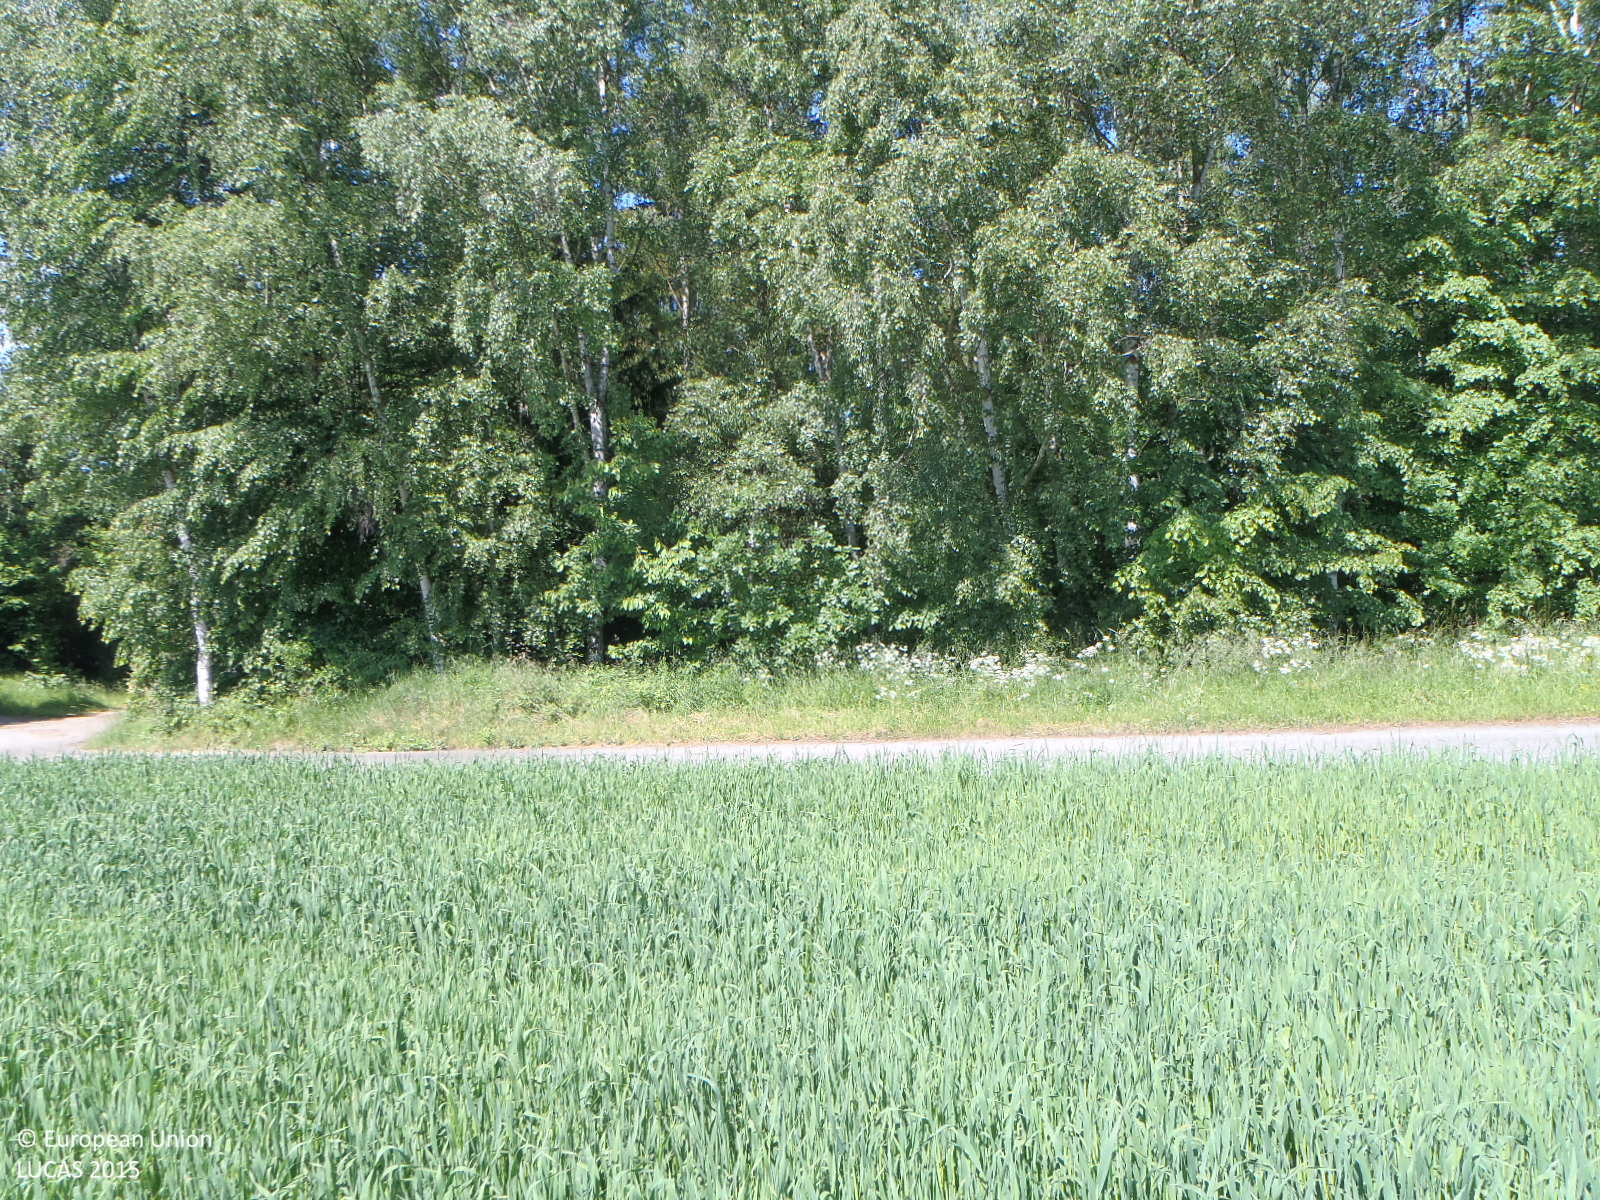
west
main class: Cropland
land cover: Oats
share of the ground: > 75 %
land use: Agriculture (excluding fallow land and kitchen gardens)
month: June
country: CZ
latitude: 48.8933
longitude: 14.3792
